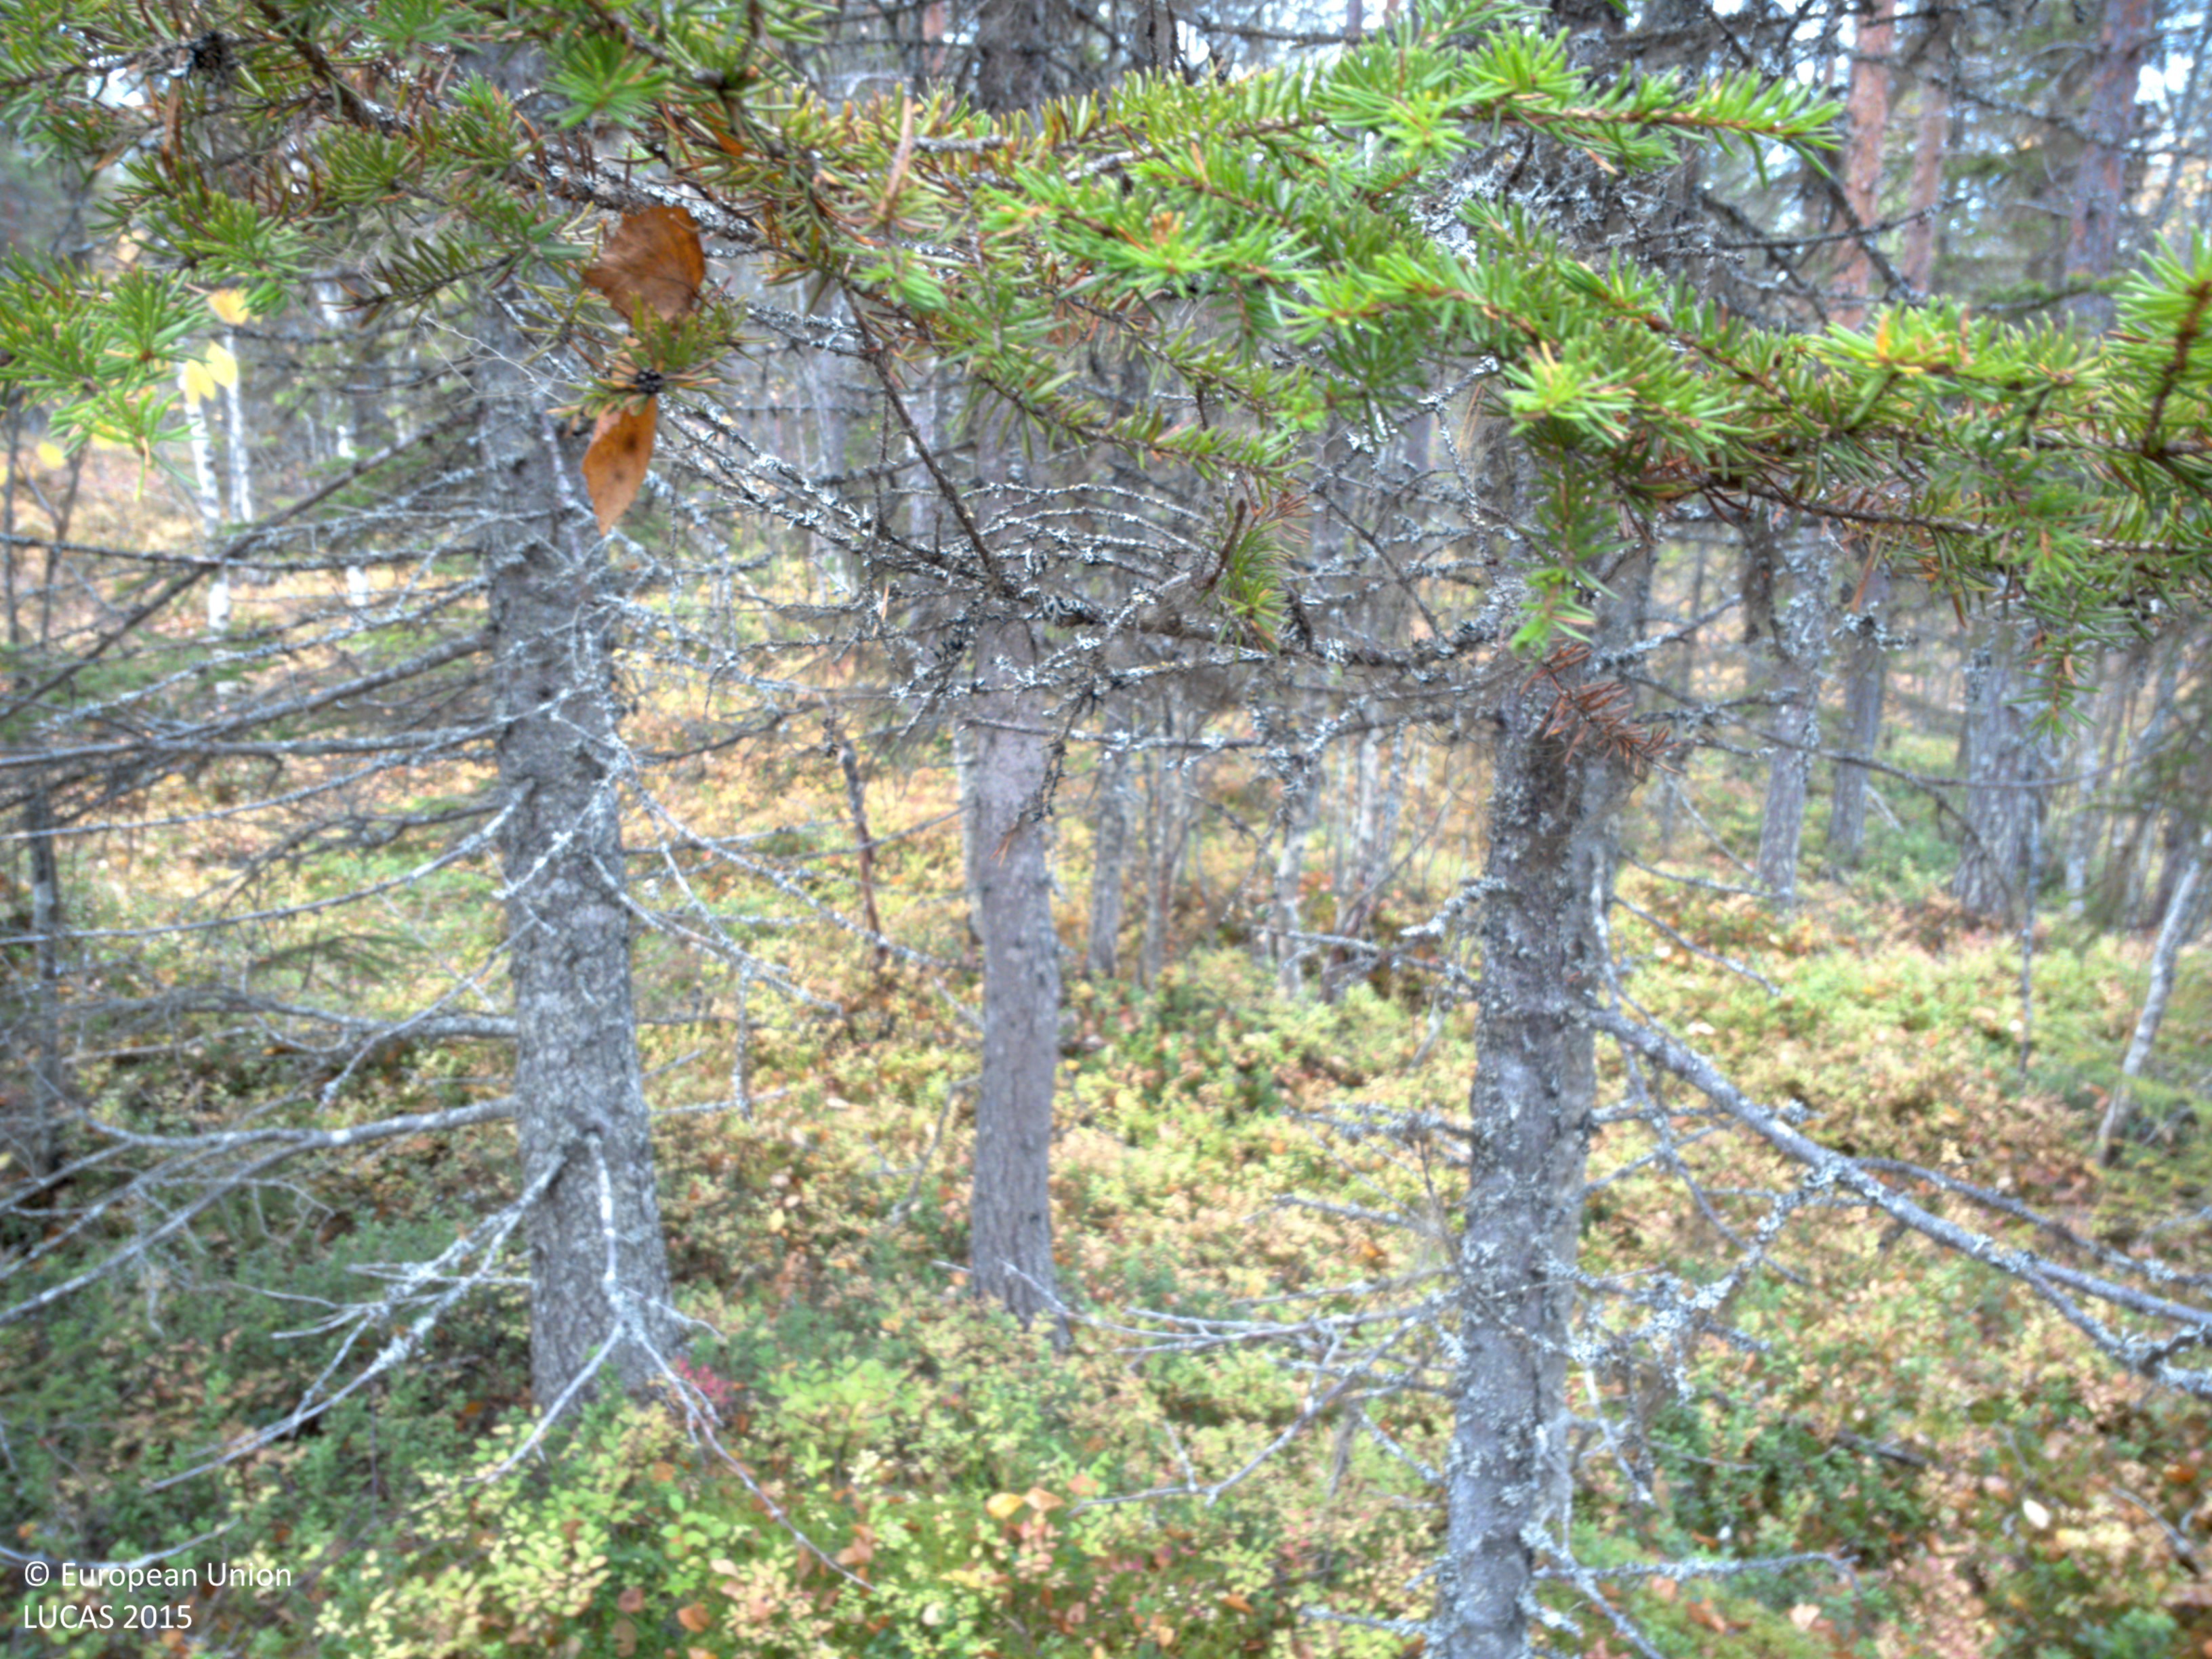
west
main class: Woodland
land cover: Other coniferous woodland
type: boreal forest
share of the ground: 50 - 75 %
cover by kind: coniferous forest trees 65 %, shrubs 20 %, broadleaved forest trees 5 %, herbaceous plants 5 %, lichens and mosses 5 %
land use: Forestry
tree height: > 5 m
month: October
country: SE
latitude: 64.9819
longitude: 17.9109
